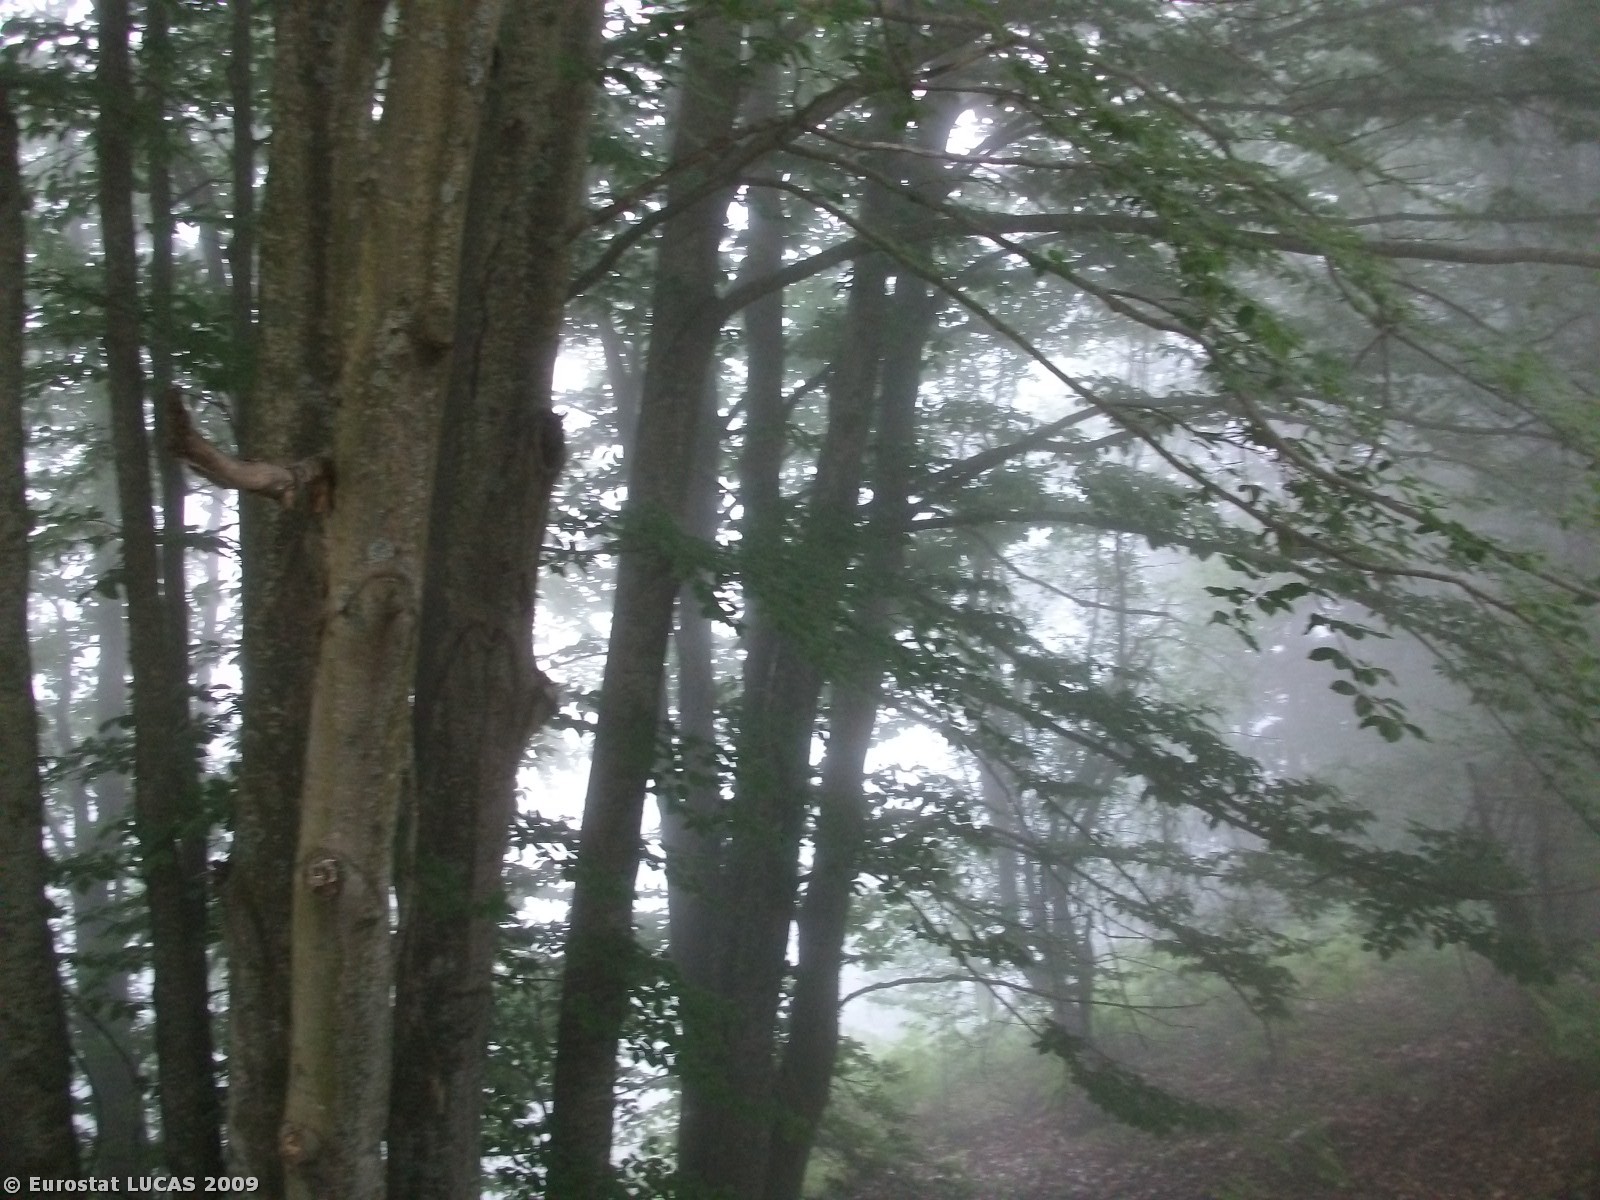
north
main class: Woodland
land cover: Broadleaved woodland
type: beech forest
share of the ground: > 75 %
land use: Forestry
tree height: > 5 m
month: May
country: GR
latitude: 39.8501
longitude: 22.6289
